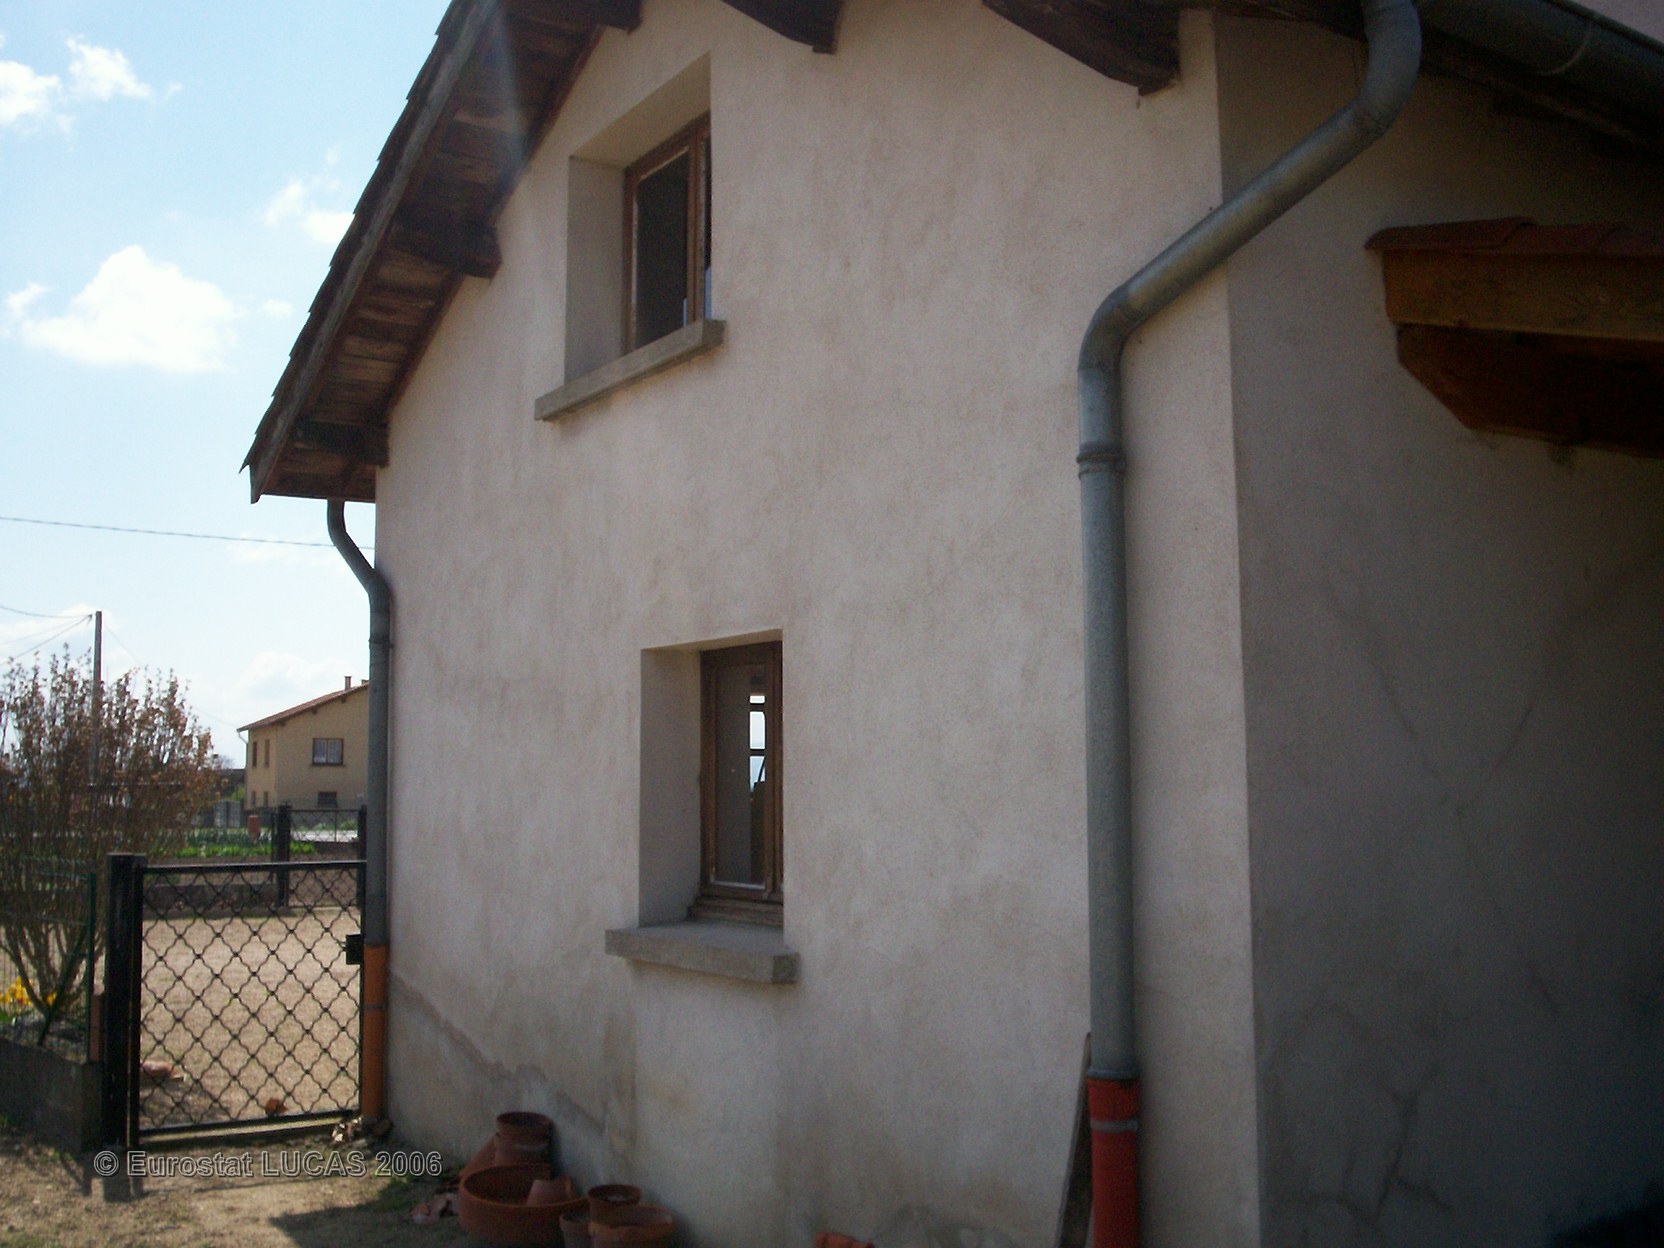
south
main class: Bare land
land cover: Bare land
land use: Fallow land
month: April
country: FR
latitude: 45.7385
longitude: 4.1292
